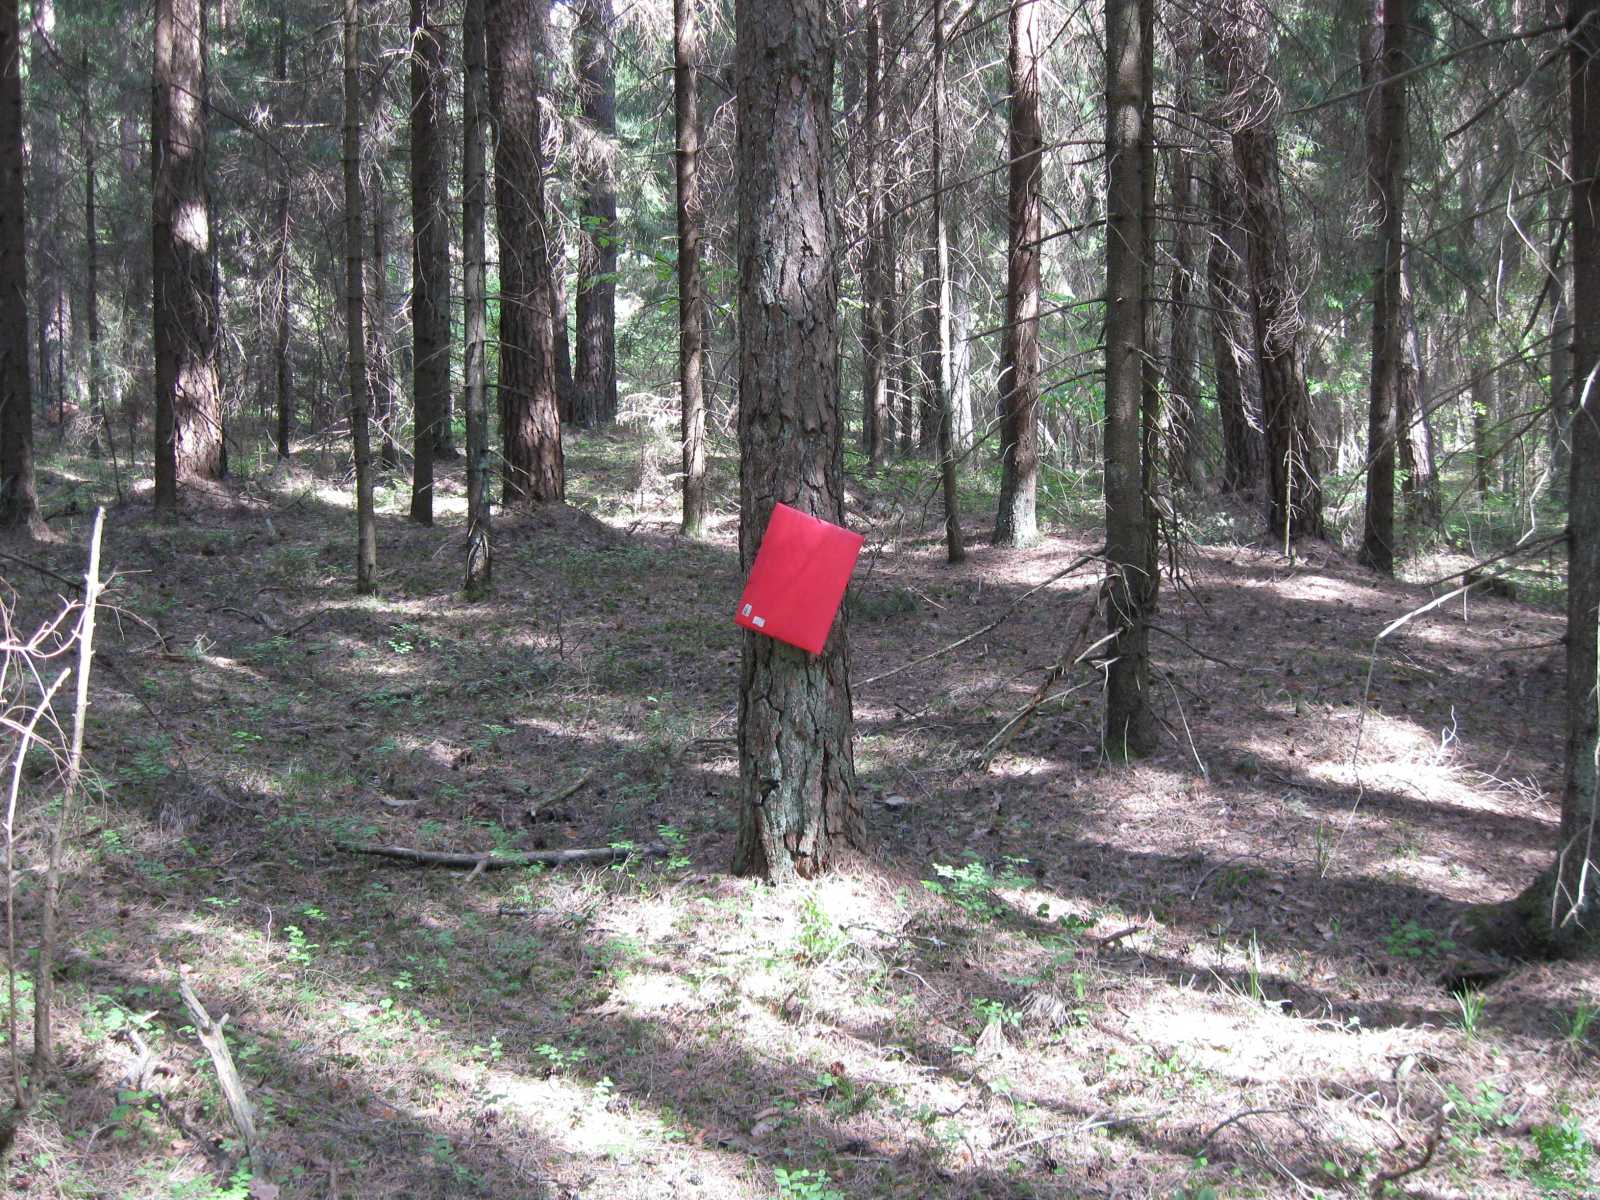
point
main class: Woodland
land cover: Other coniferous woodland
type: hemiboreal forest and nemoral coniferous forest and mixed broadleaved-coniferous forest
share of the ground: > 75 %
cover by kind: coniferous forest trees 100 %
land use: Forestry
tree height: > 5 m
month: June
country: LT
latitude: 54.6199
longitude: 23.9198
